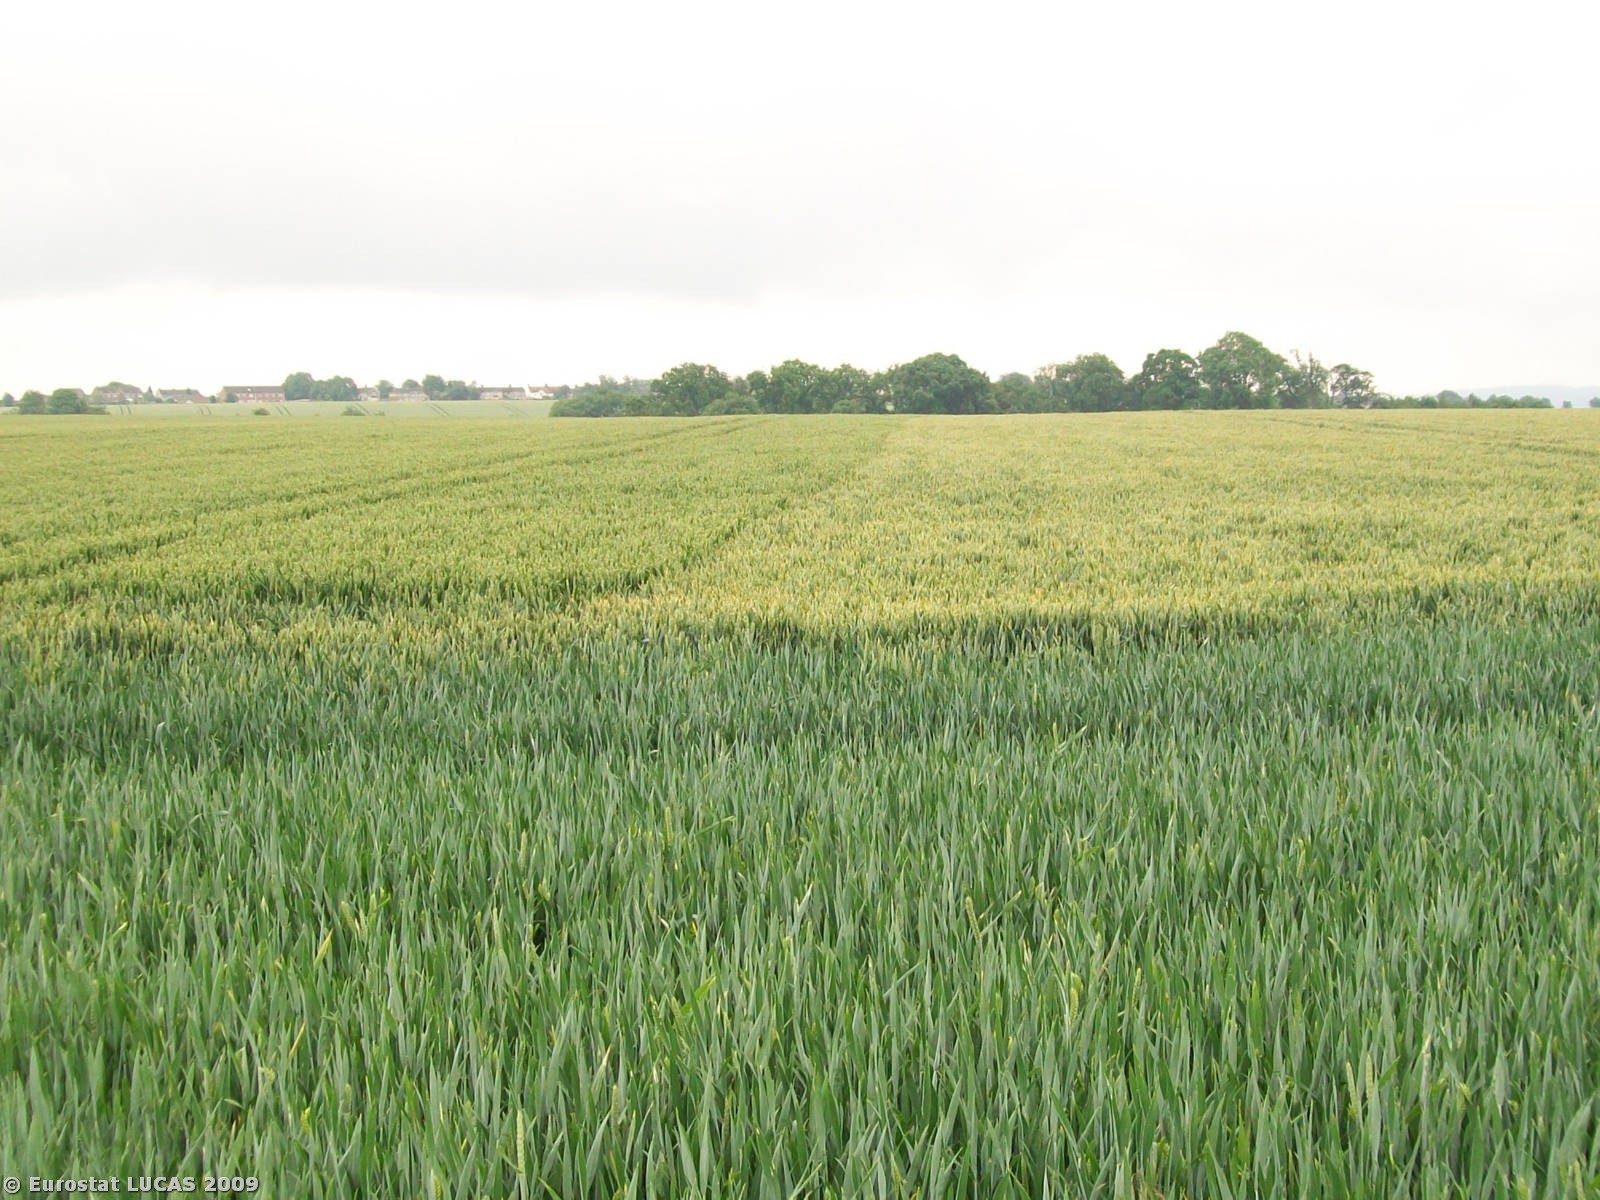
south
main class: Cropland
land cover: Common wheat
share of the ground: > 75 %
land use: Agriculture (excluding fallow land and kitchen gardens)
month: June
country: GB
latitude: 51.2368
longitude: -2.1929
